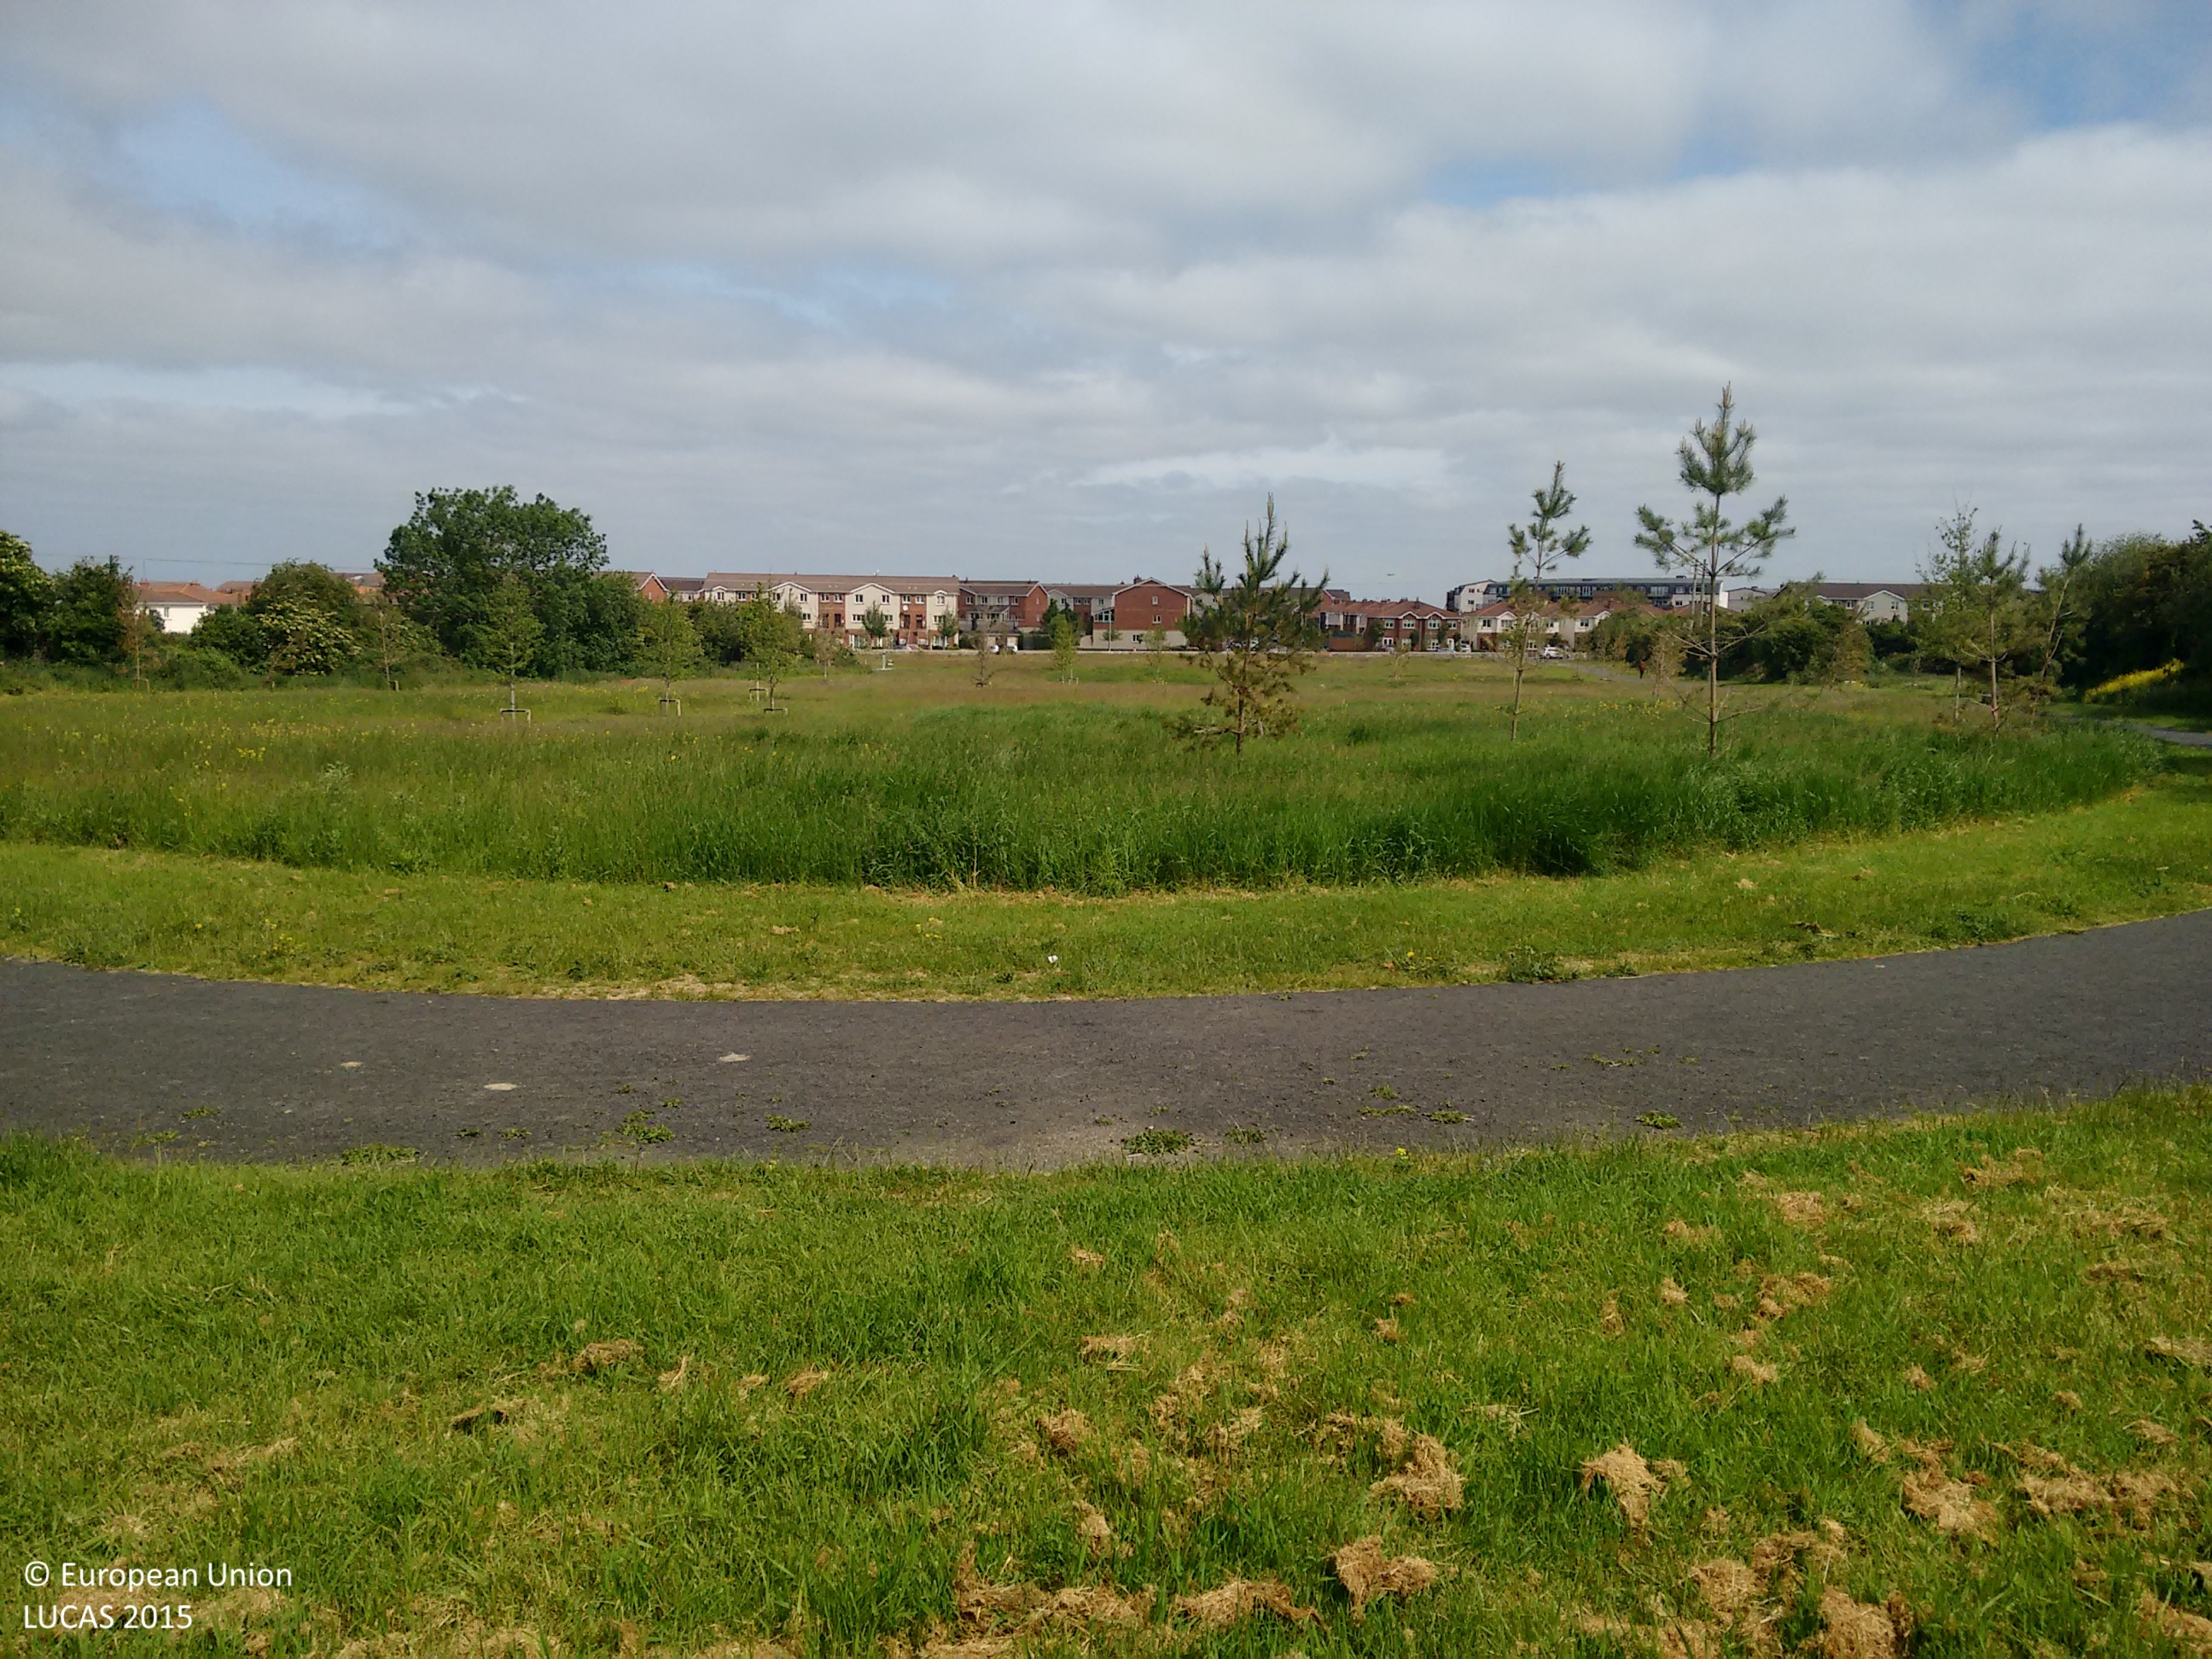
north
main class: Grassland
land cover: Grassland with sparse tree/shrub cover
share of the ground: > 75 %
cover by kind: herbaceous plants 95 %, broadleaved forest trees 5 %
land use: Amenities, museums, leisure
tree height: < 5 m
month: June
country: IE
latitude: 53.2793
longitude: -6.4273
